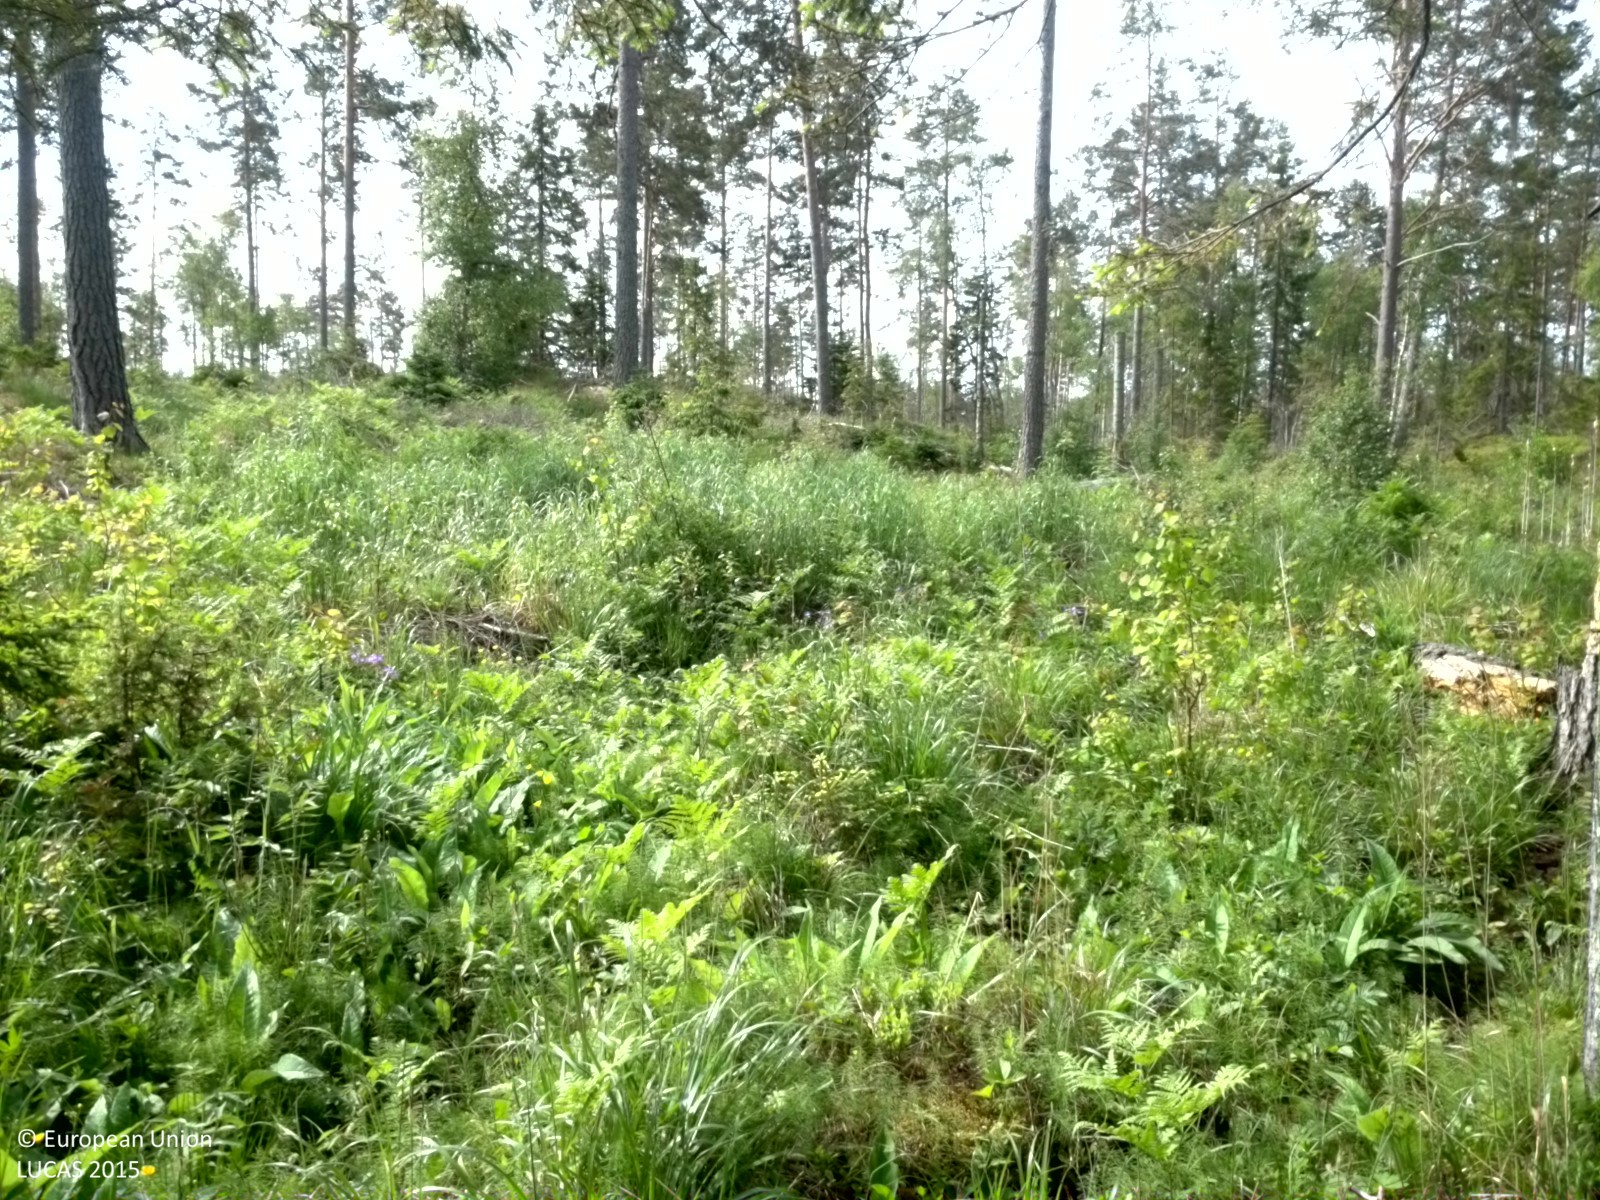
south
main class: Woodland
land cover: Spruce dominated mixed woodland
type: boreal forest
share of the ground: 50 - 75 %
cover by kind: herbaceous plants 35 %, coniferous forest trees 30 %, broadleaved forest trees 30 %, shrubs 5 %
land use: Forestry
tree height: > 5 m
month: June
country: SE
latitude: 60.3326
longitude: 18.0174
